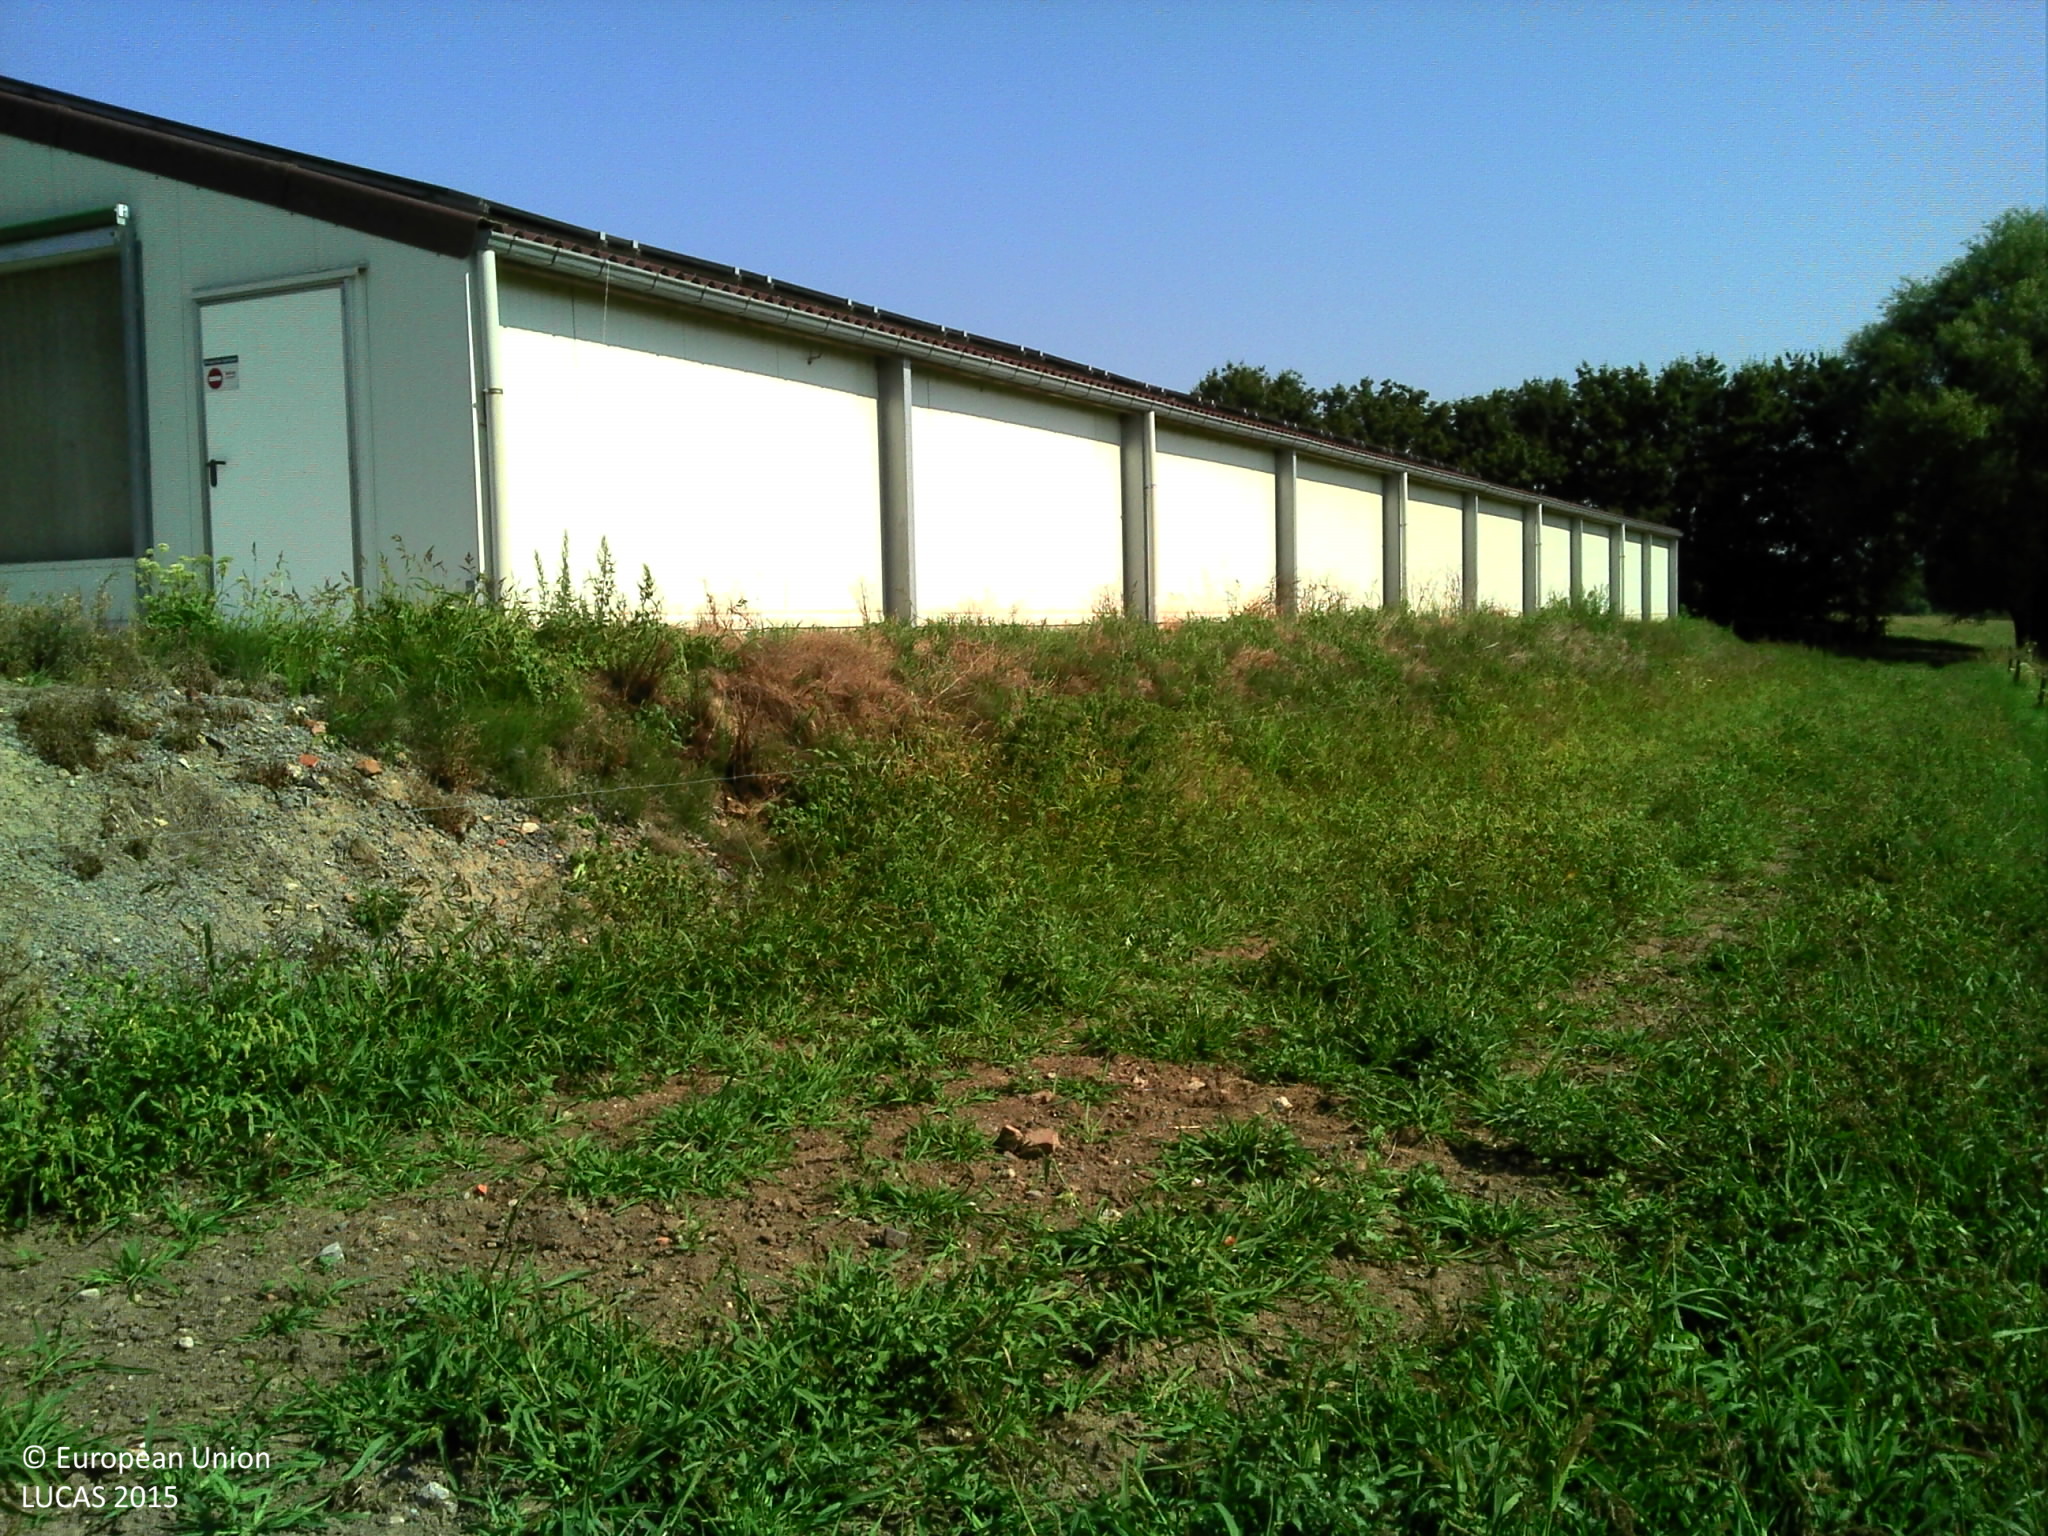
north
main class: Grassland
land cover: Spontaneously vegetated surfaces
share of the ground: > 75 %
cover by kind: herbaceous plants 100 %
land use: Agriculture (excluding fallow land and kitchen gardens)
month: August
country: BE
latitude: 50.6758
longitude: 4.0083
